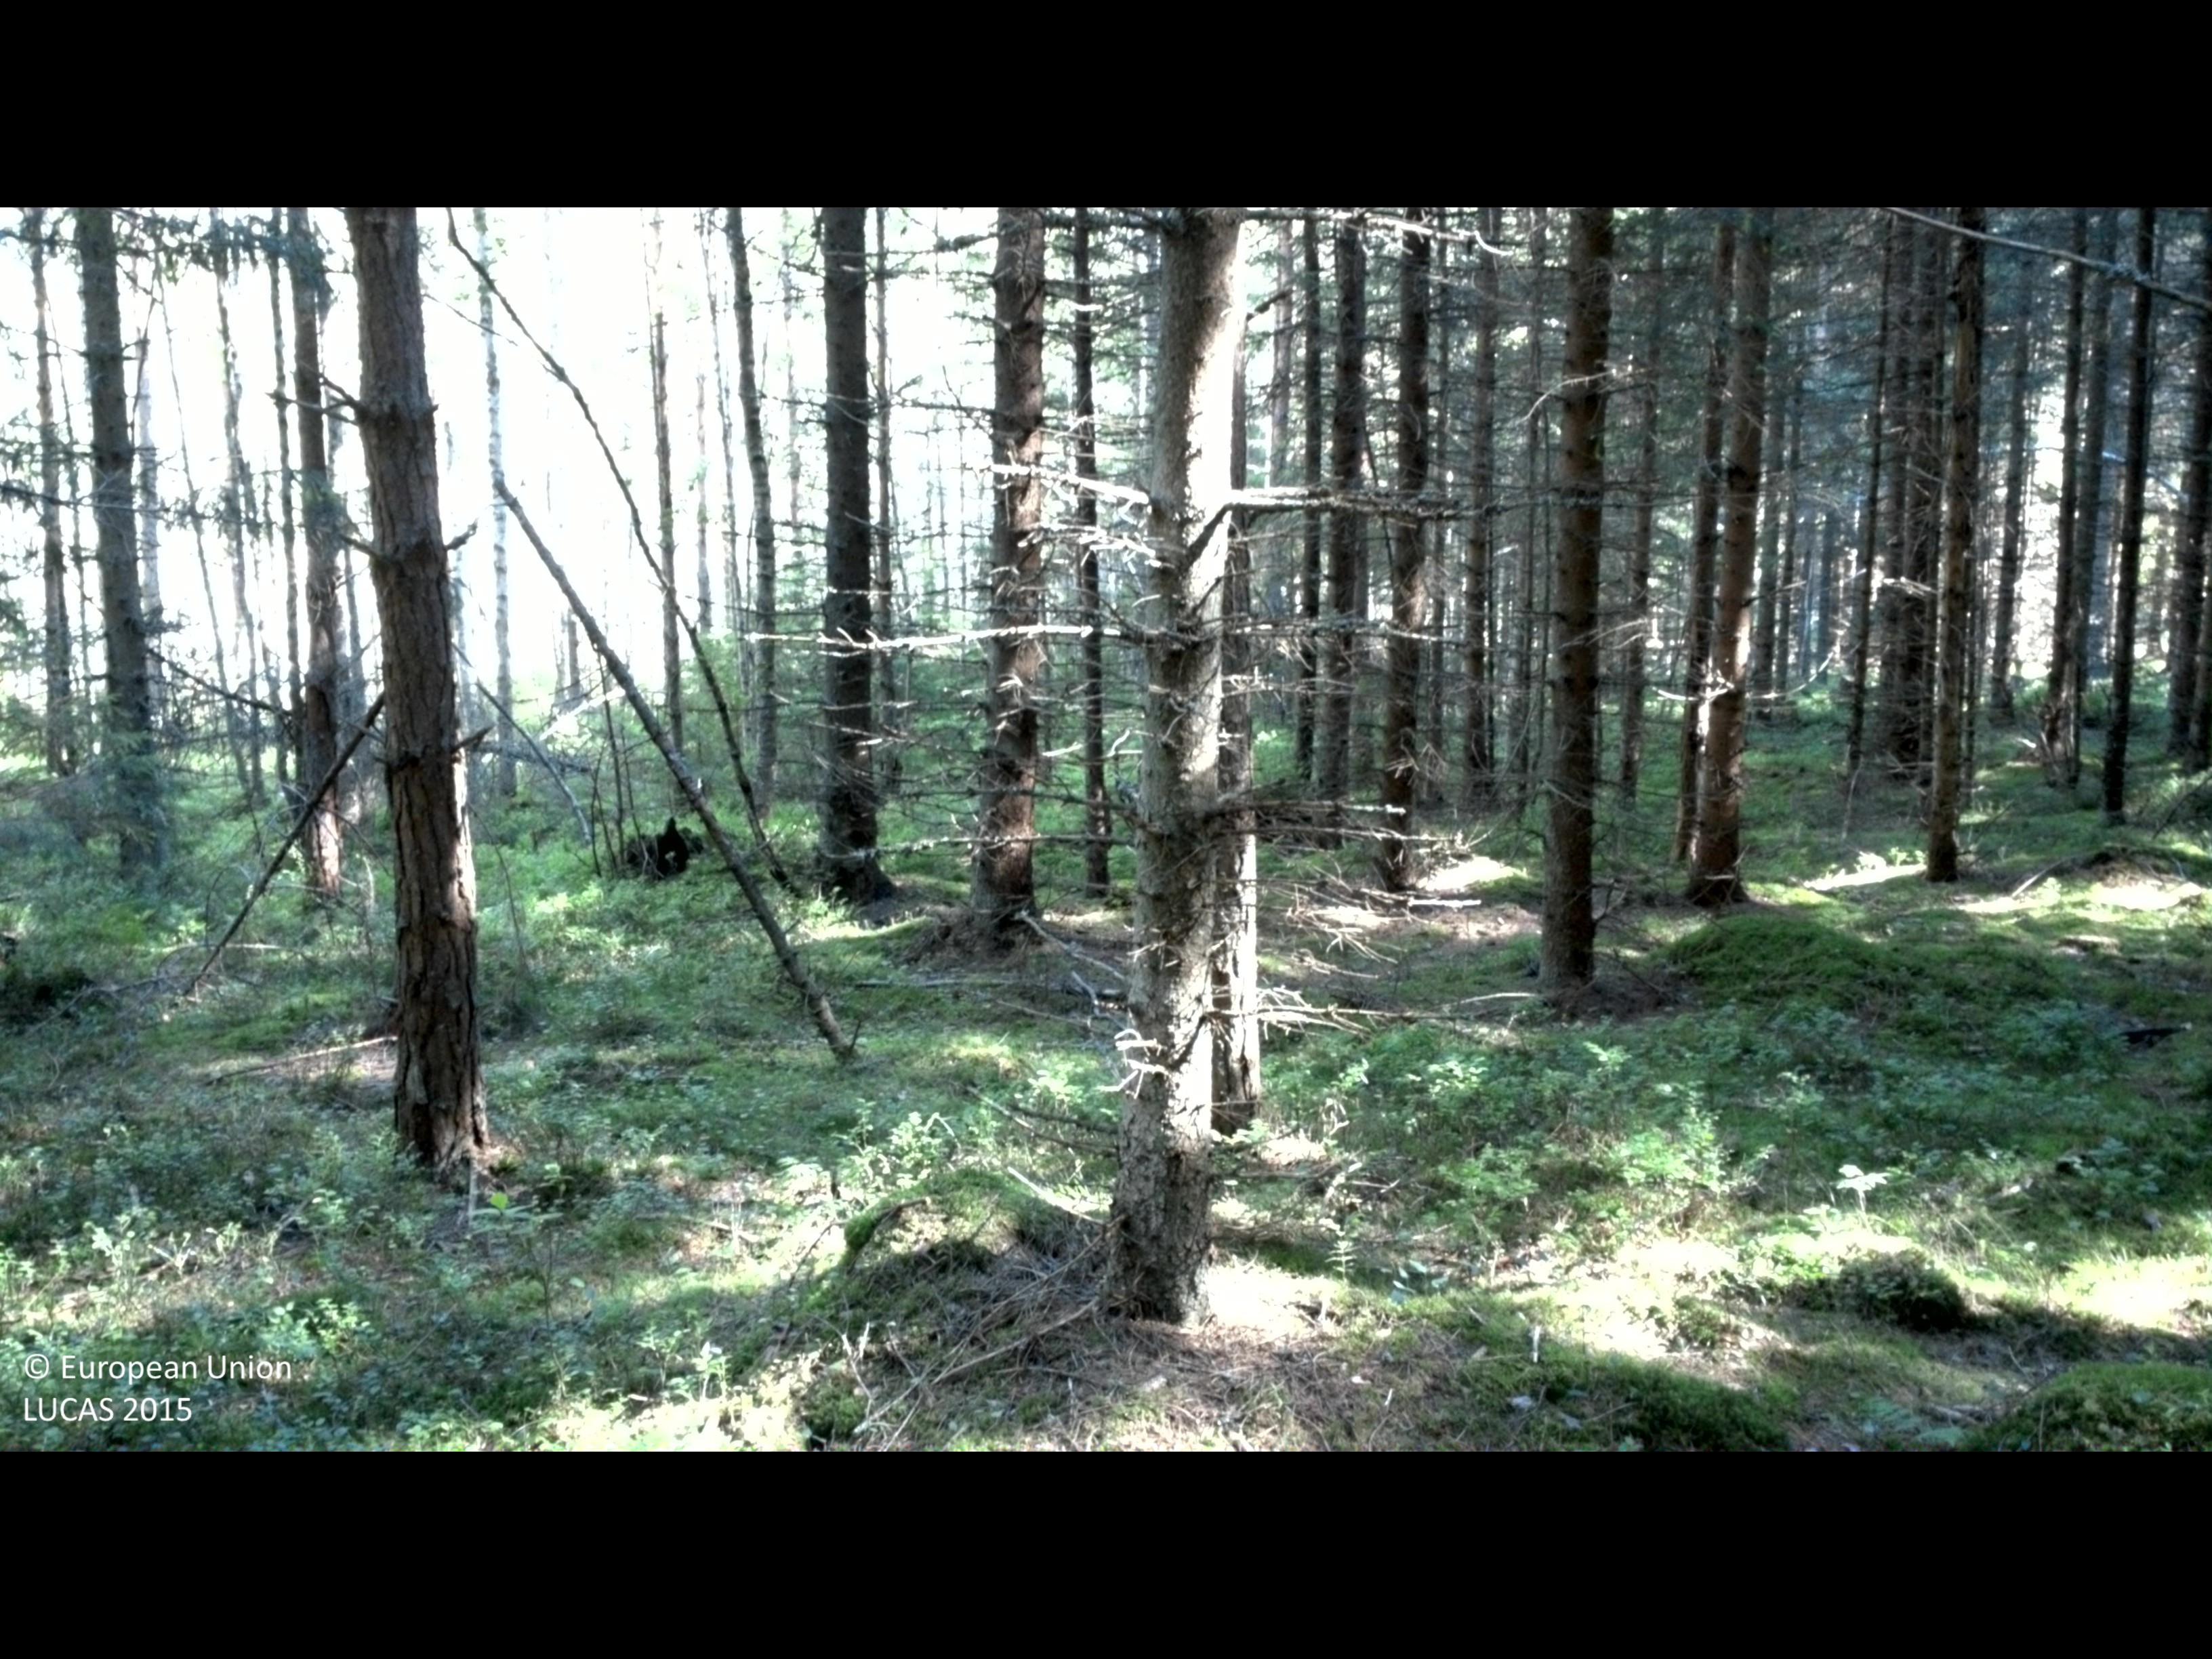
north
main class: Woodland
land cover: Spruce dominated coniferous woodland
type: boreal forest
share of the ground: > 75 %
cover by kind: coniferous forest trees 85 %, lichens and mosses 10 %, shrubs 5 %
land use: Forestry
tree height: > 5 m
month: July
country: SE
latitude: 58.2009
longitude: 16.2408
